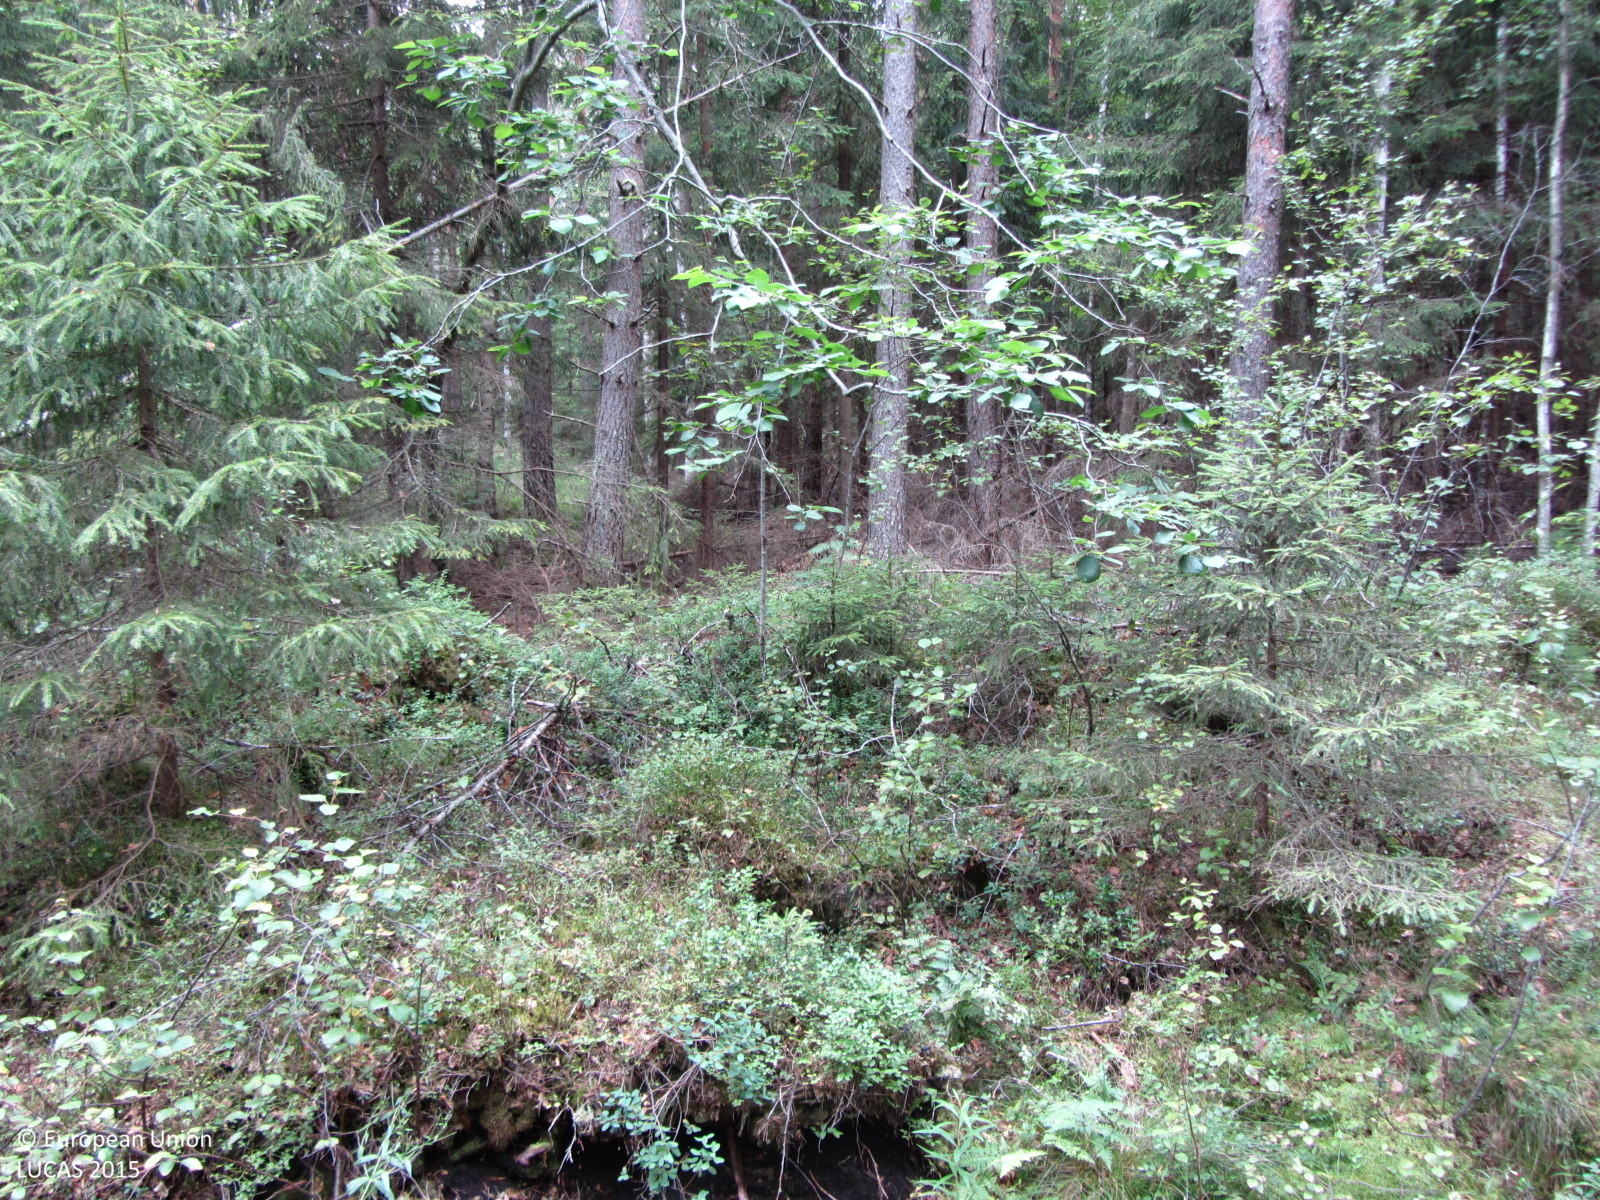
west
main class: Woodland
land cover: Other mixed woodland
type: boreal forest
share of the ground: > 75 %
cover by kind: coniferous forest trees 45 %, broadleaved forest trees 40 %, shrubs 15 %
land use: Forestry
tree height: > 5 m
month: July
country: FI
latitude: 60.5469
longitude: 24.3045
